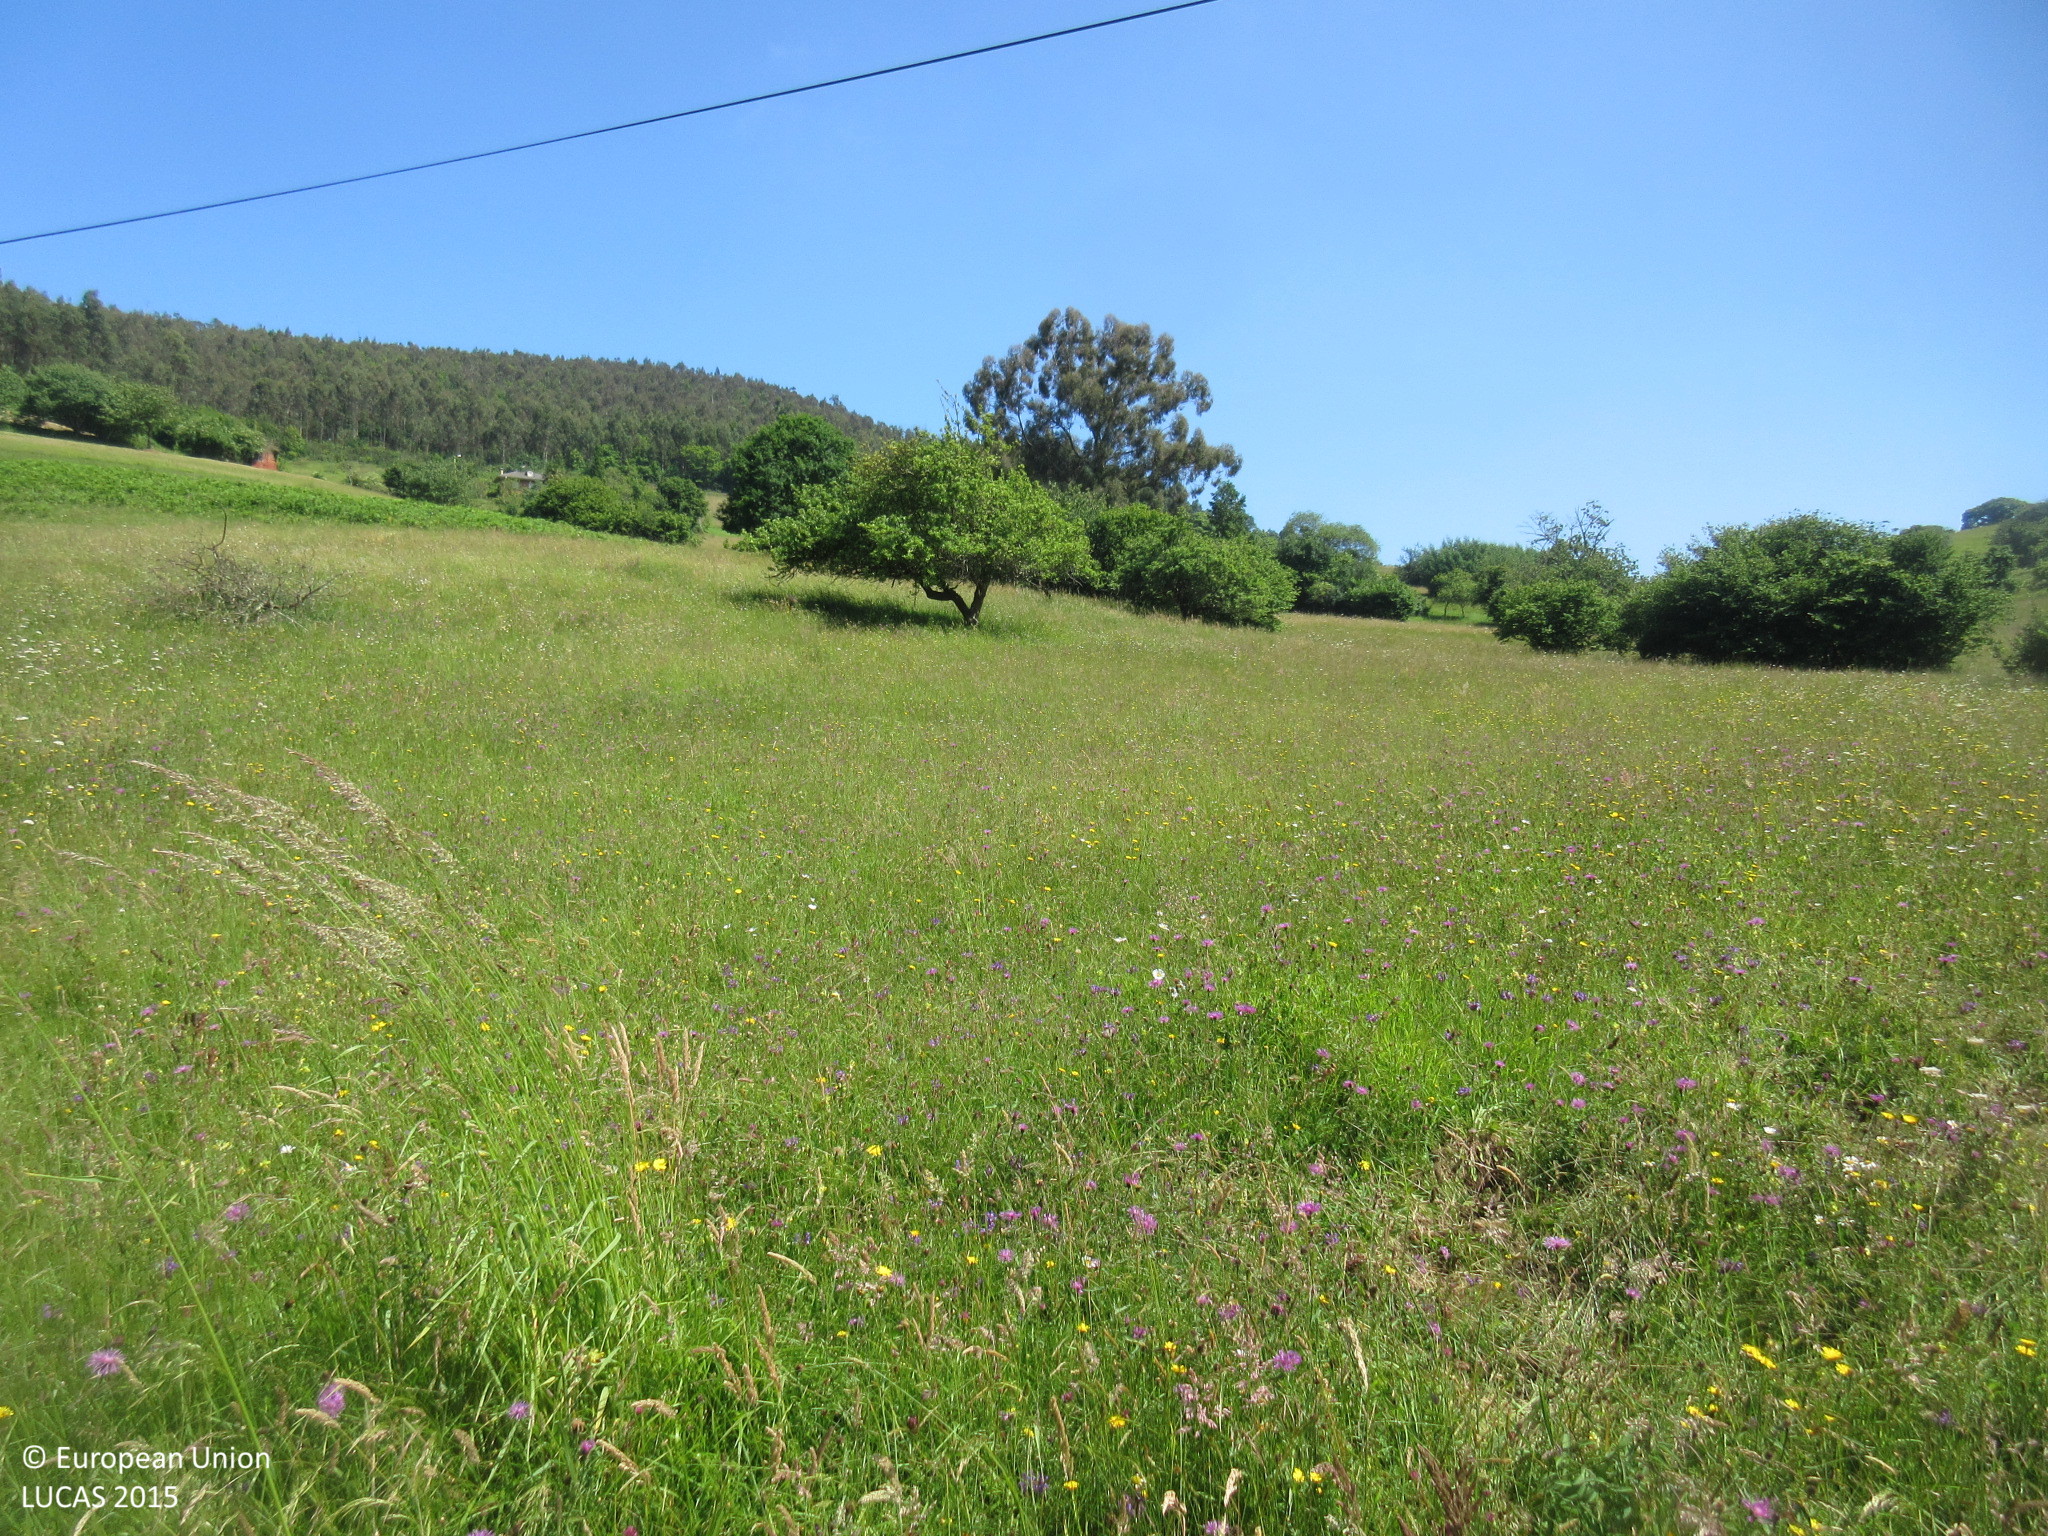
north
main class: Grassland
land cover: Grassland without tree/shrub cover
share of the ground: > 75 %
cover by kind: herbaceous plants 100 %
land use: Agriculture (excluding fallow land and kitchen gardens)
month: June
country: ES
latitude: 43.4764
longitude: -6.0539
